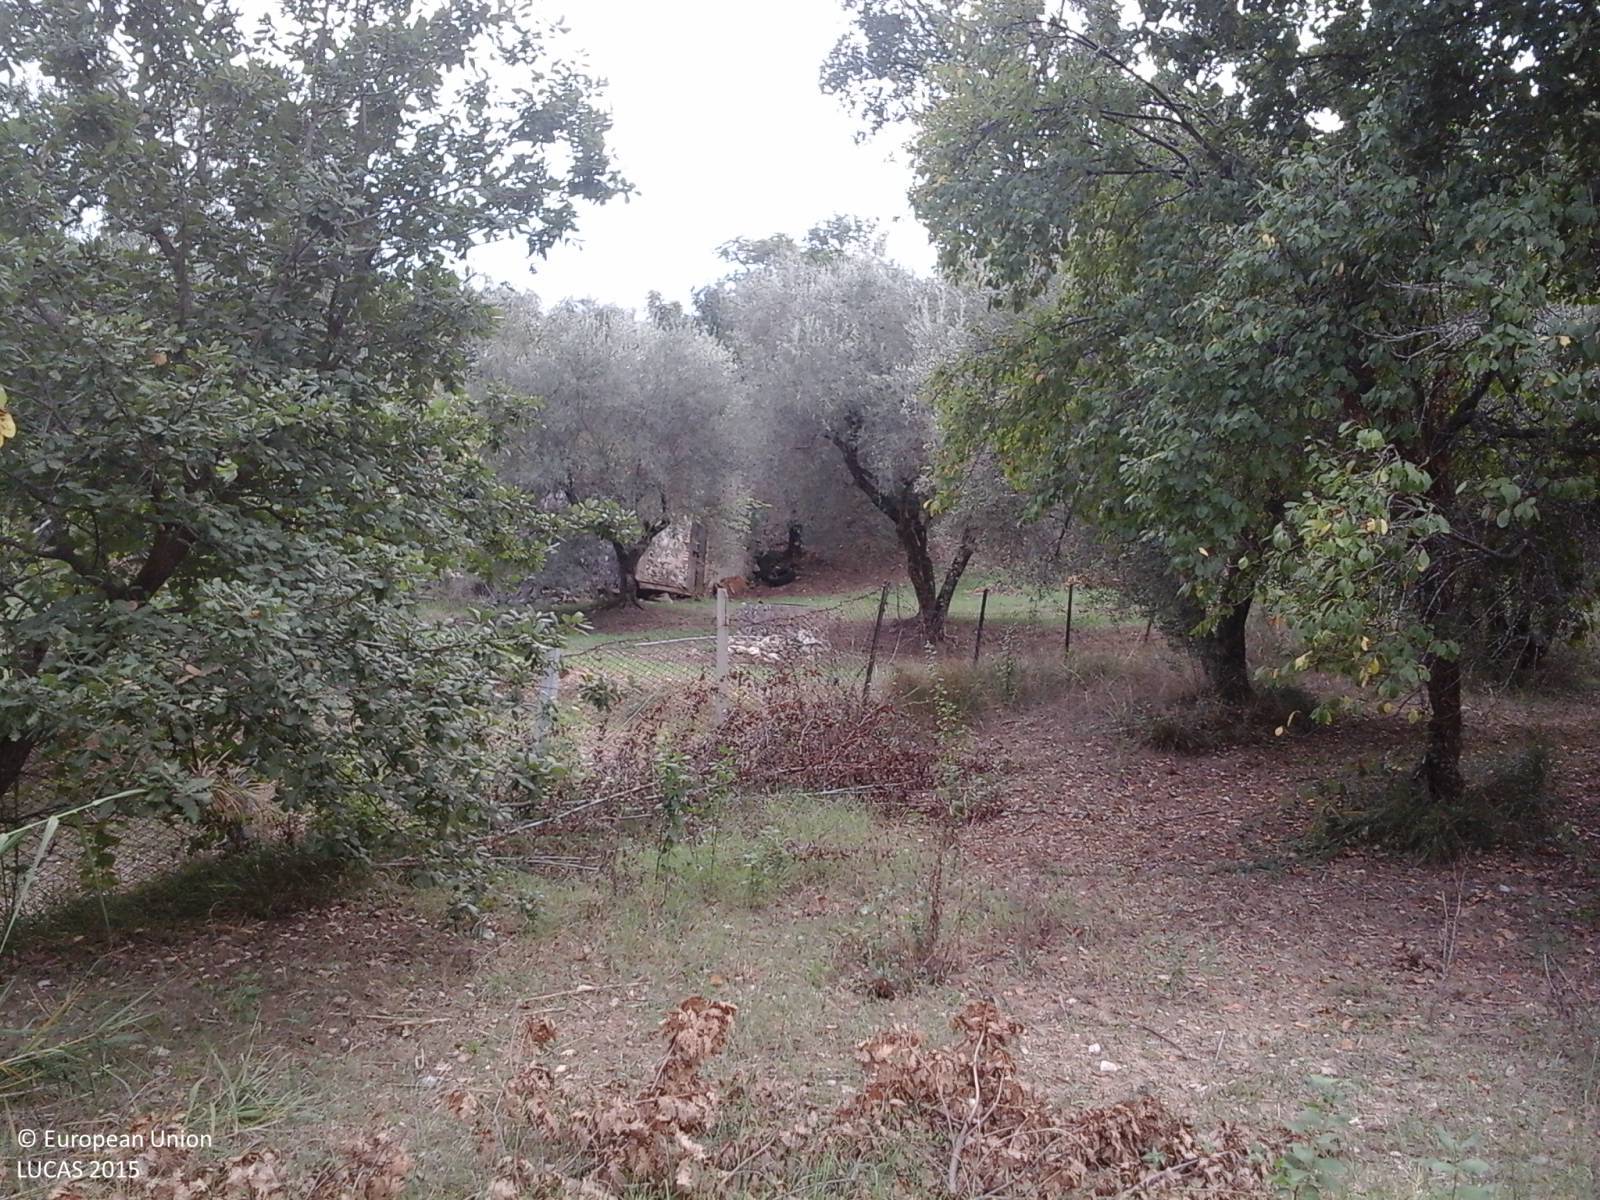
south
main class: Grassland
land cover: Spontaneously vegetated surfaces
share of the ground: > 75 %
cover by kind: herbaceous plants 100 %
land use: Agriculture (excluding fallow land and kitchen gardens)
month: September
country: IT
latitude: 41.2634
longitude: 13.7688
